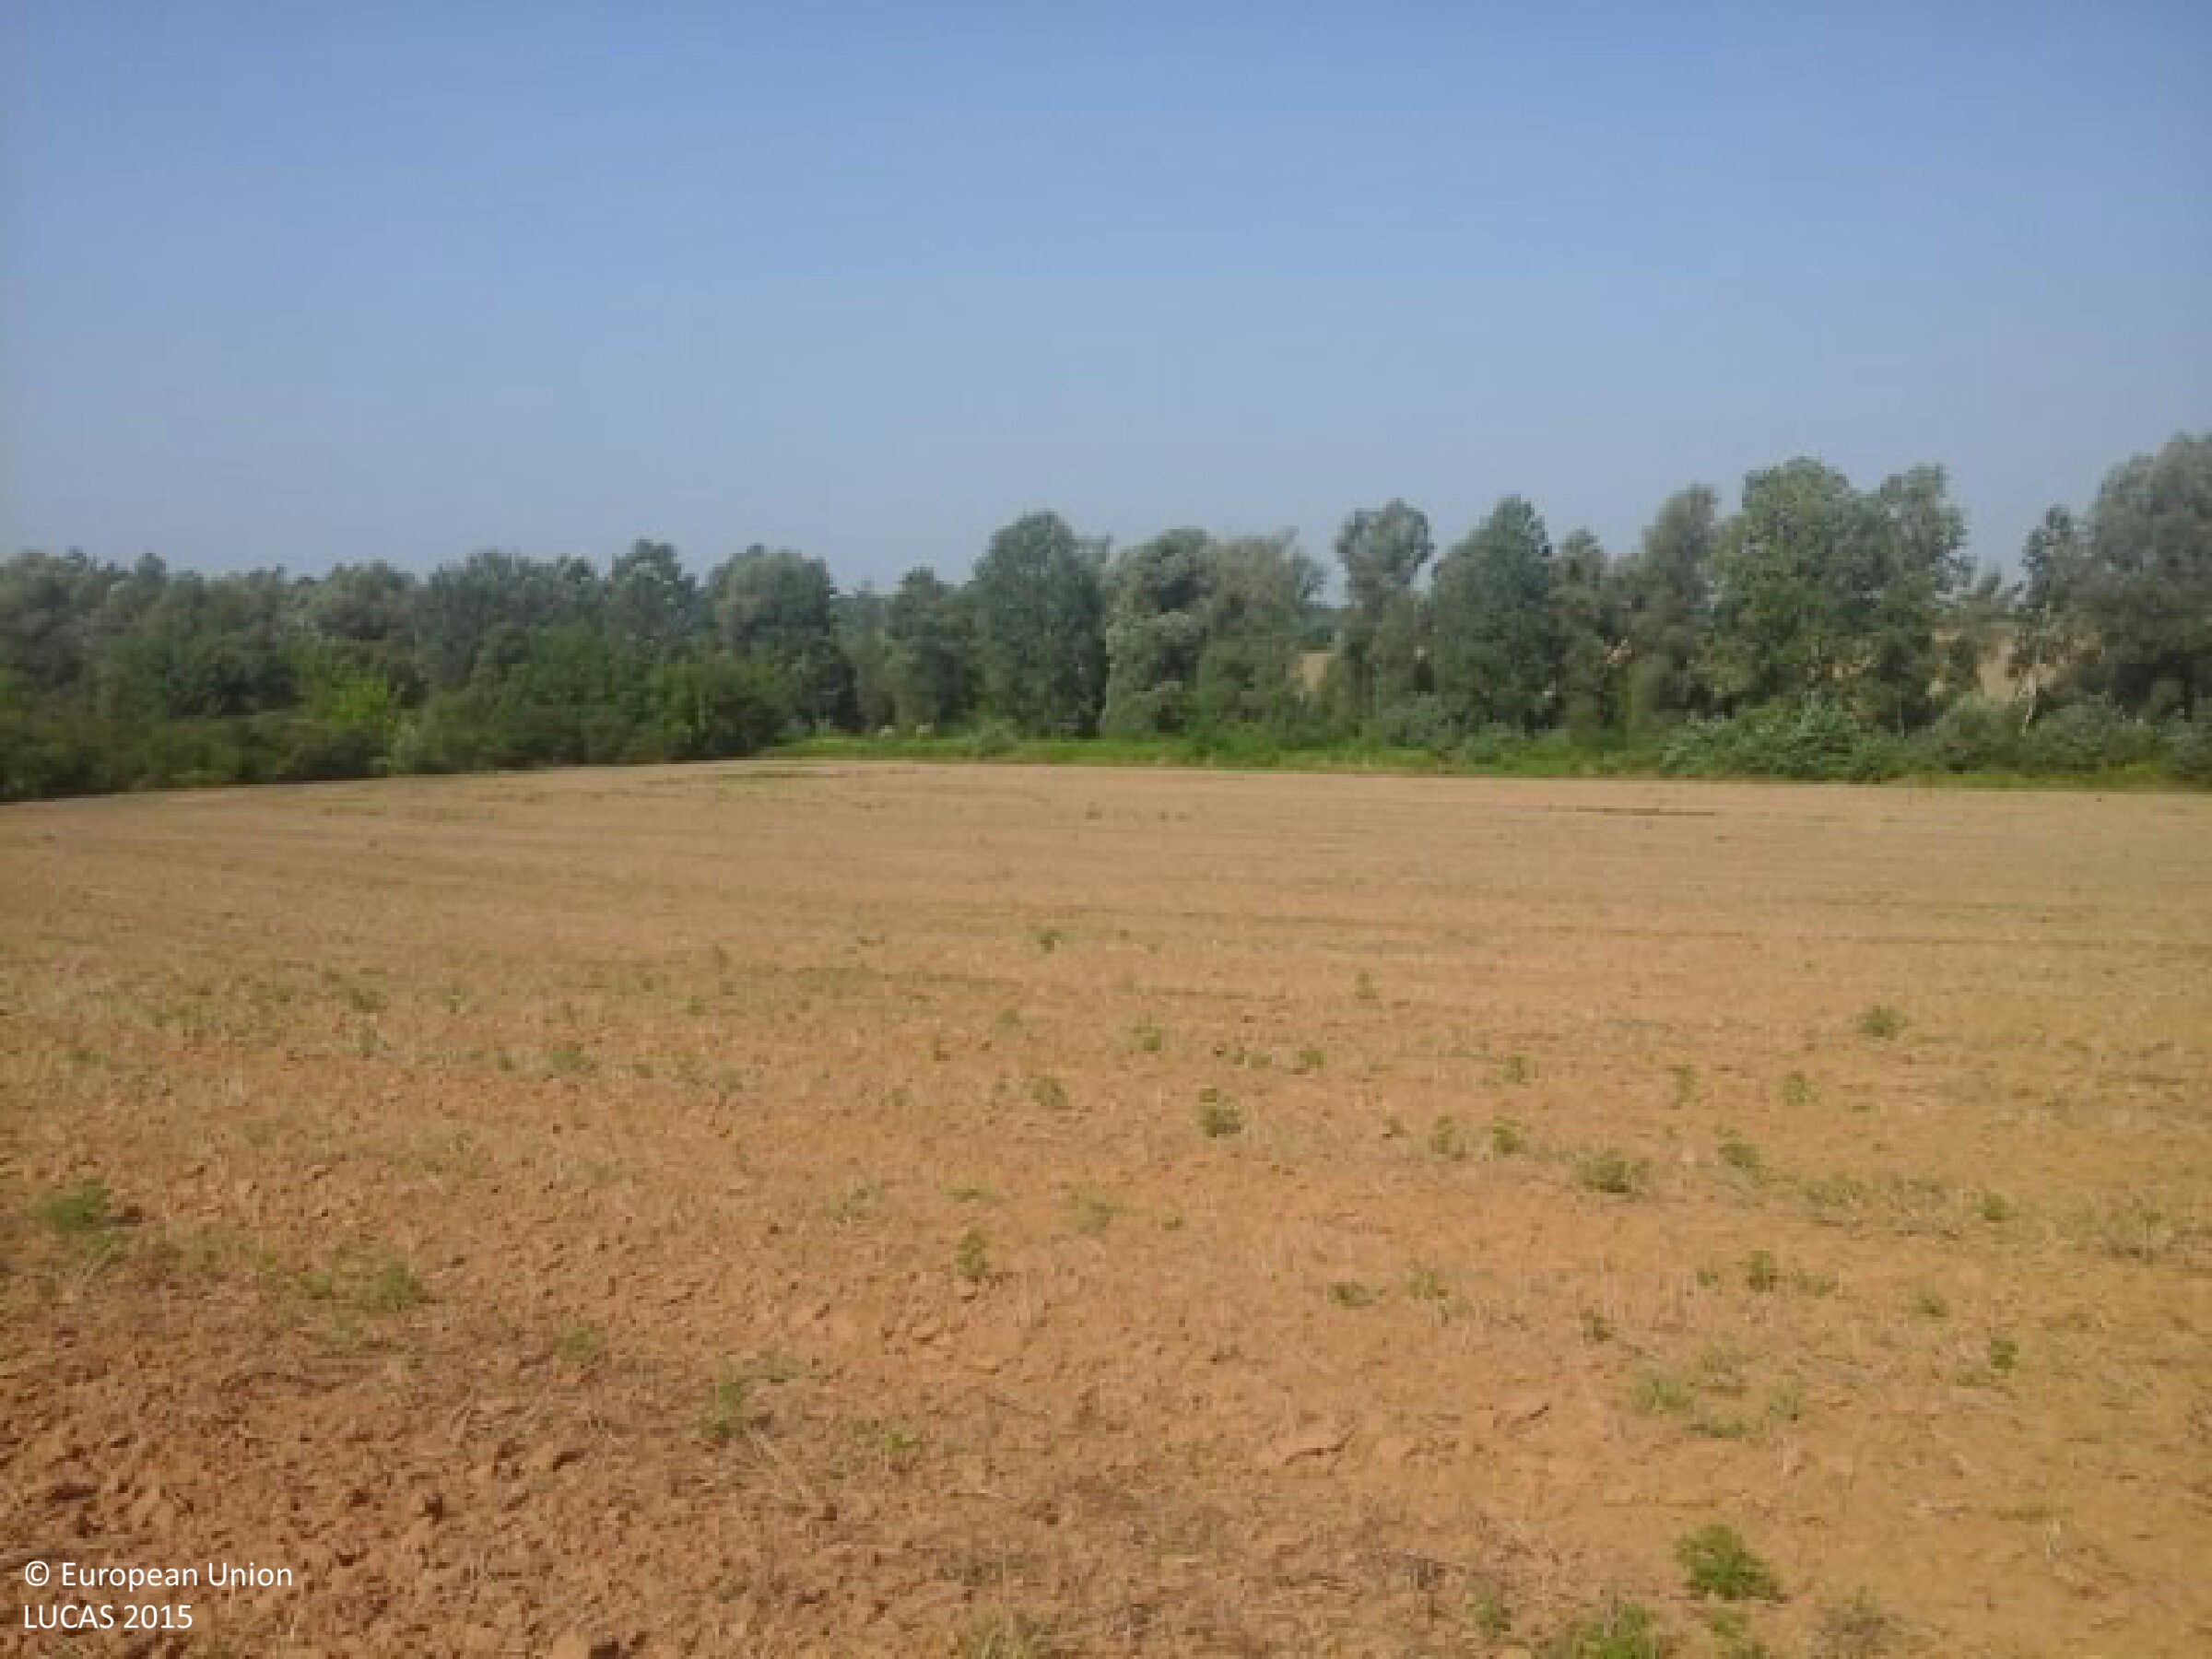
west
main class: Cropland
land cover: Triticale
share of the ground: < 10 %
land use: Agriculture (excluding fallow land and kitchen gardens)
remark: Harvested field
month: August
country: HU
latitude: 46.3611
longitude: 18.2093
